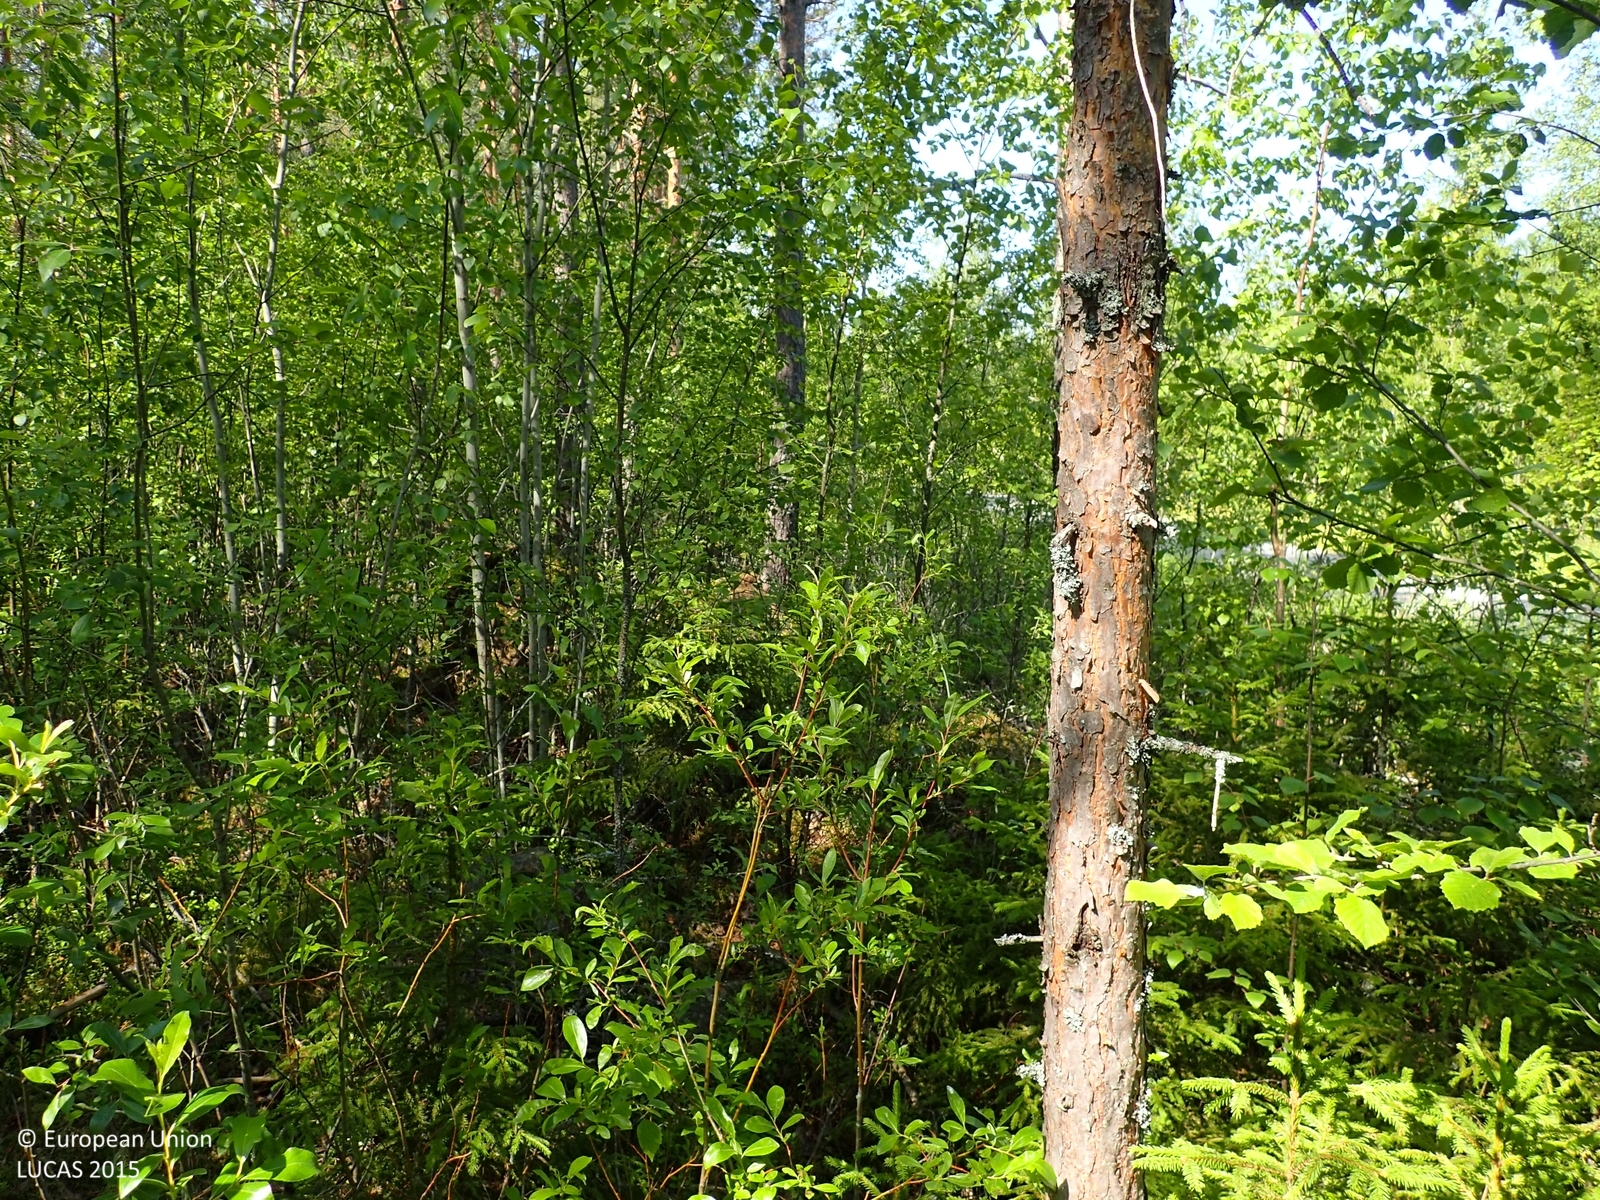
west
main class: Woodland
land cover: Pine dominated mixed woodland
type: boreal forest
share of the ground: > 75 %
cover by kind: coniferous forest trees 55 %, broadleaved forest trees 20 %, shrubs 20 %, lichens and mosses 5 %
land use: Forestry
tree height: > 5 m
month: July
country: FI
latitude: 62.8229
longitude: 21.5614
